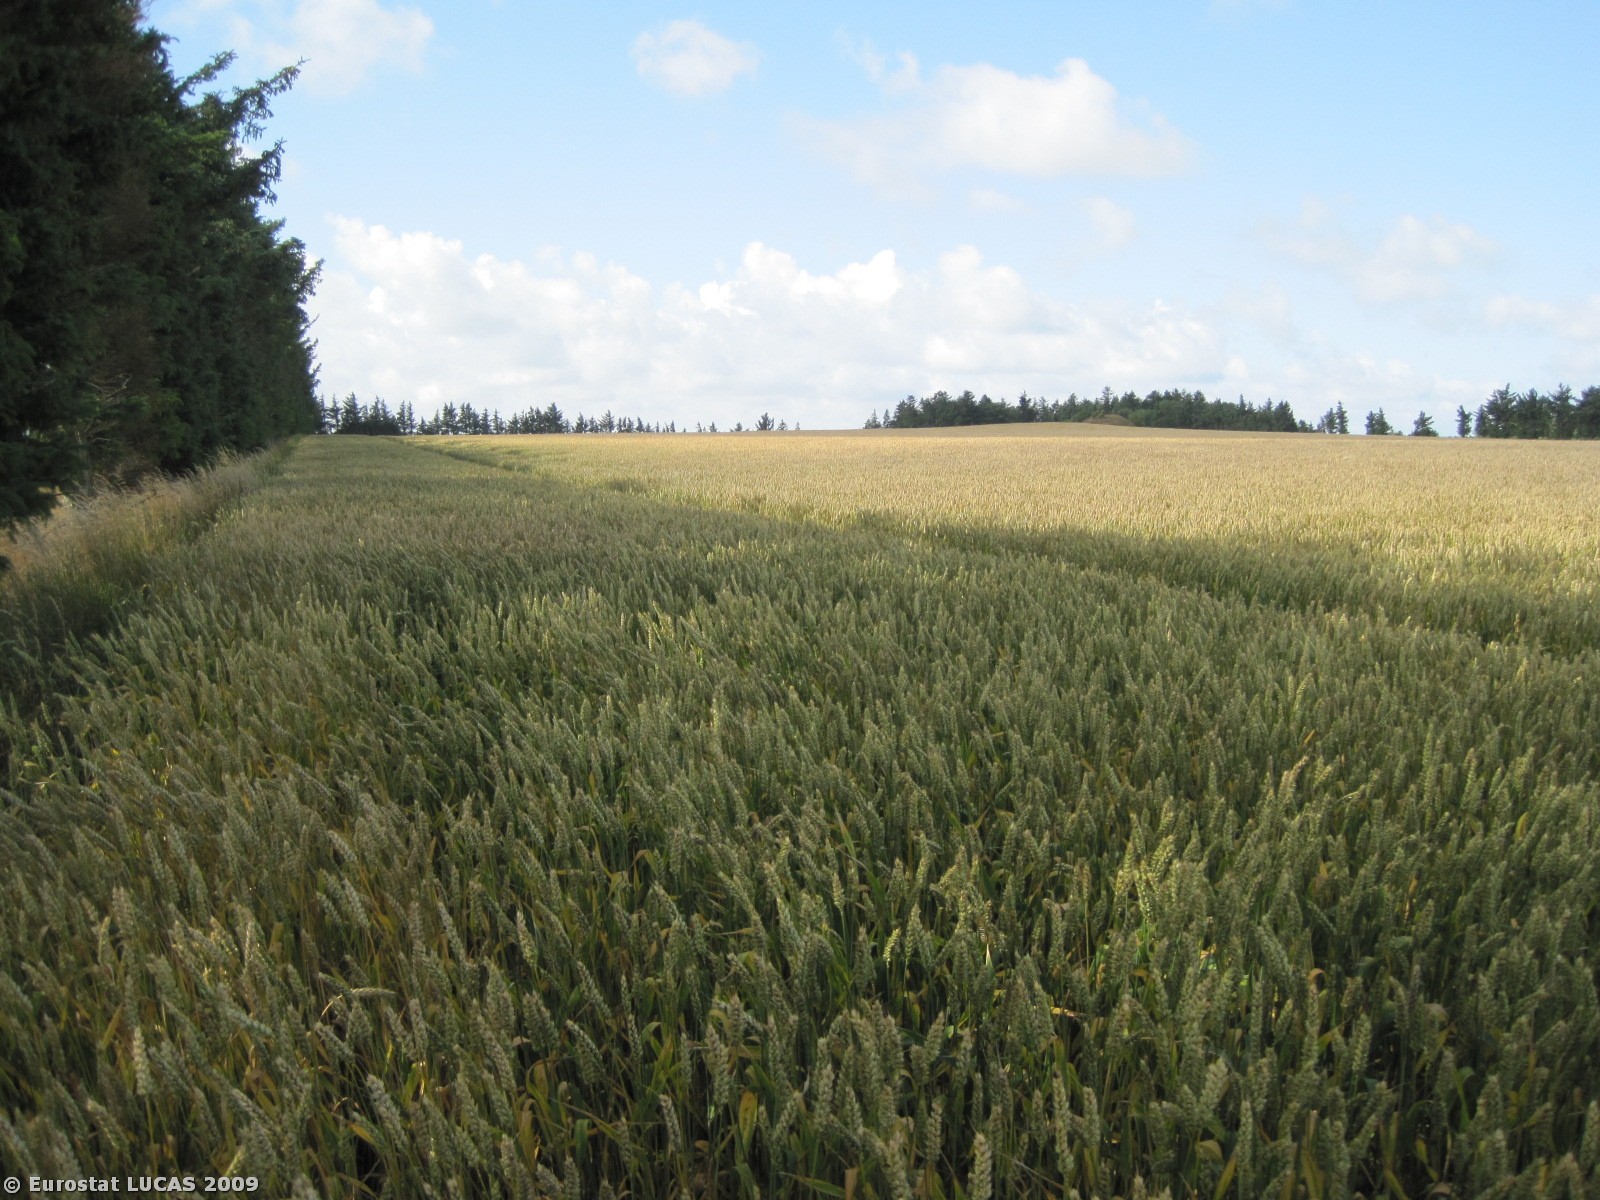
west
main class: Cropland
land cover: Common wheat
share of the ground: > 75 %
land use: Agriculture (excluding fallow land and kitchen gardens)
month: July
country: DK
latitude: 56.7002
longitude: 8.4832
